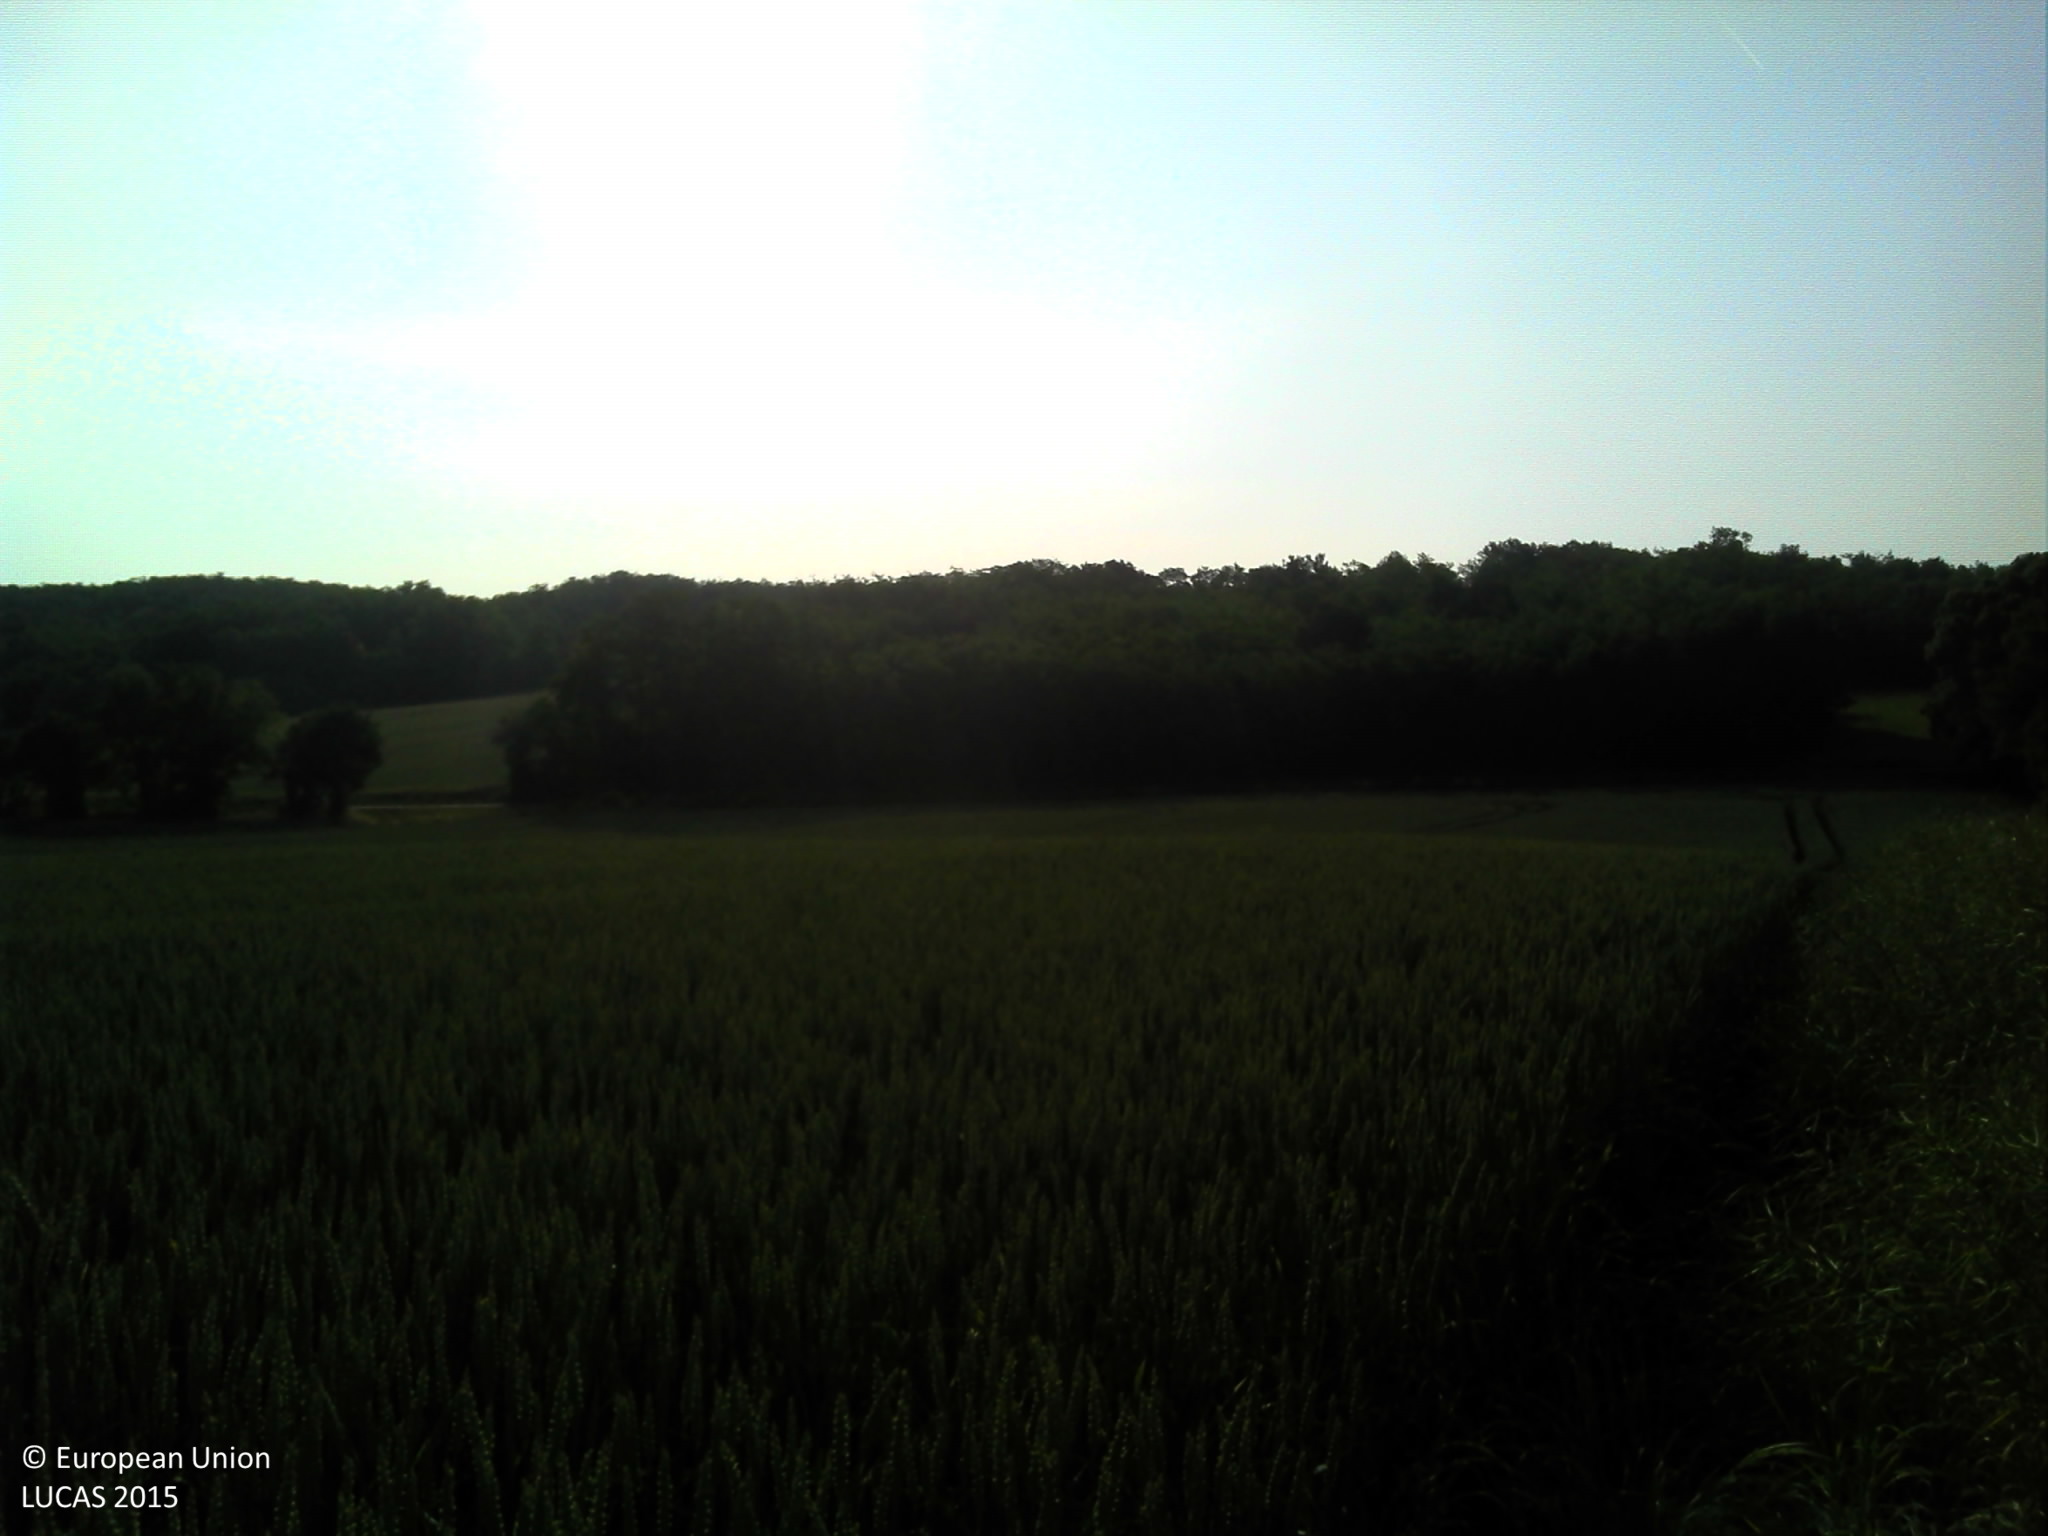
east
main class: Cropland
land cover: Rape and turnip rape
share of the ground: > 75 %
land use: Agriculture (excluding fallow land and kitchen gardens)
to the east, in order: Rape and turnip rape; Common wheat; Spontaneously vegetated surfaces; Paved roads, cycling and walking lanes; Grass margins; Broadleaved woodland
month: June
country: FR
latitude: 46.5173
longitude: 4.8794
